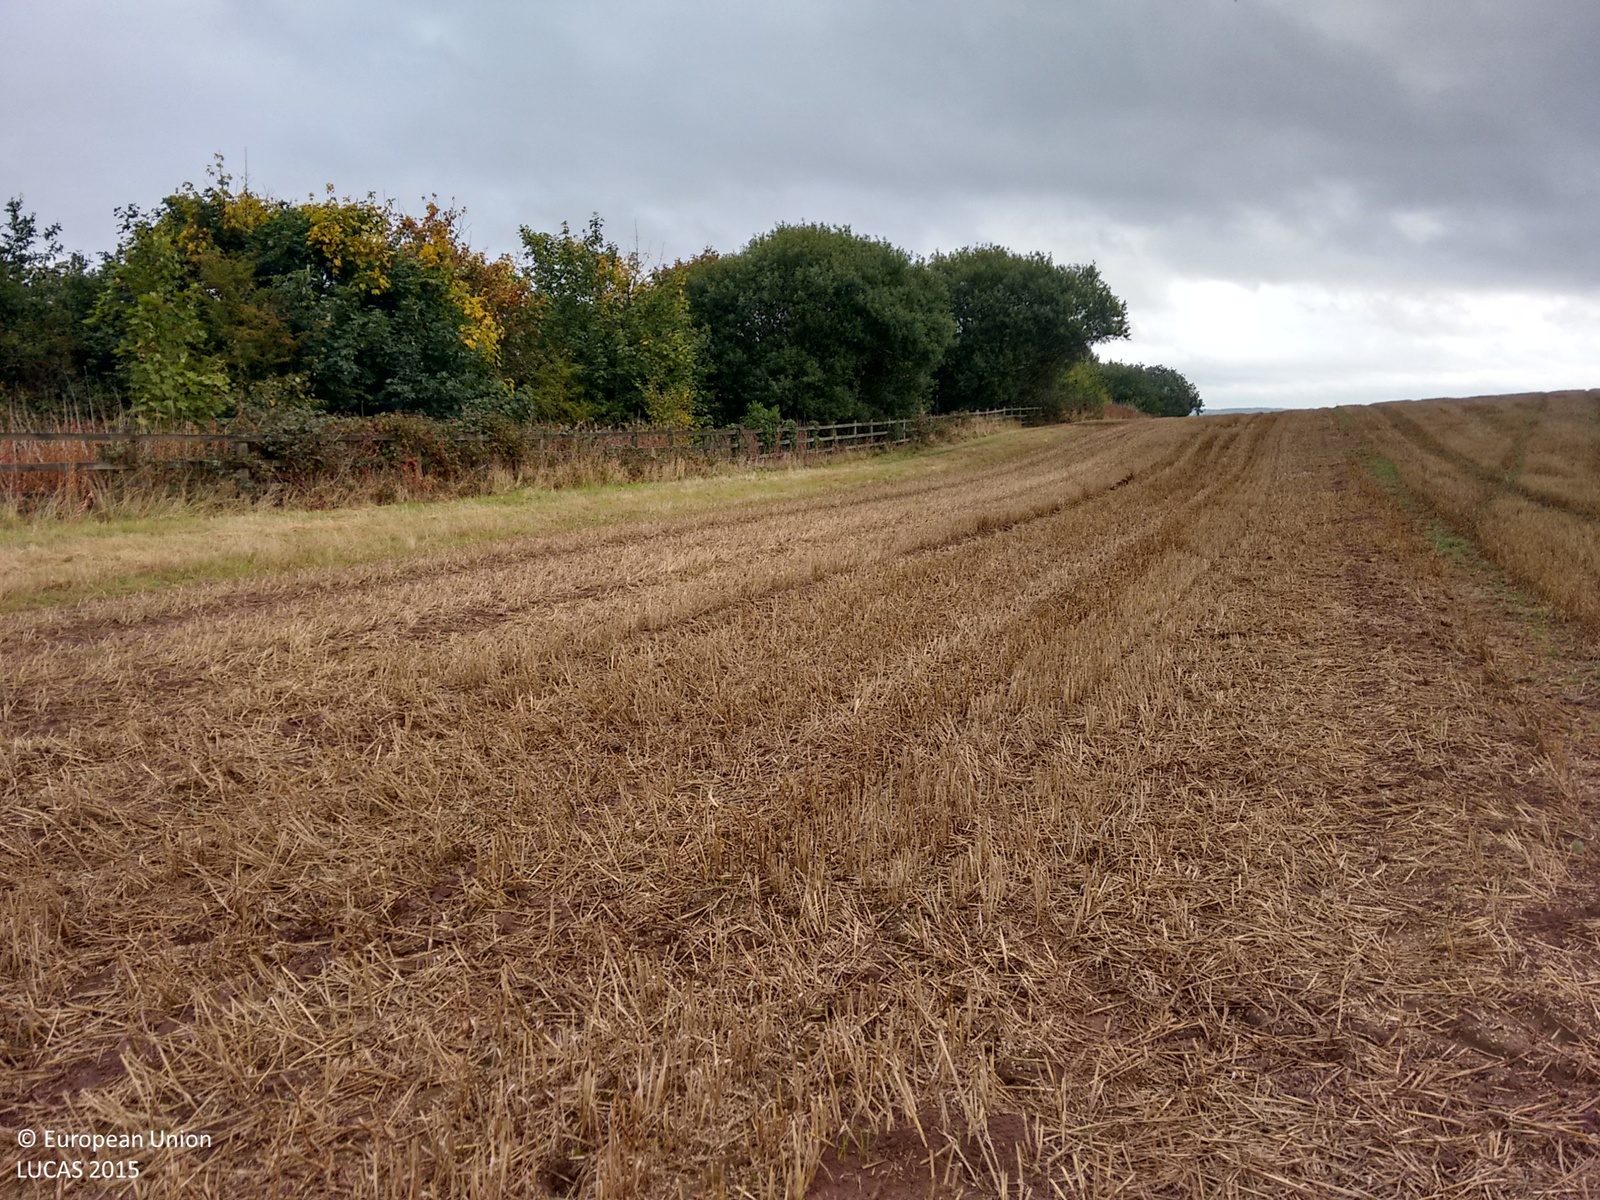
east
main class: Cropland
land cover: Common wheat
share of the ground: 10 - 25 %
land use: Agriculture (excluding fallow land and kitchen gardens)
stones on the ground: < 10 %
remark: Harvested field
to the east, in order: Common wheat; Grassland without tree/shrub cover; Fences; Spontaneously vegetated surfaces; Ditches and canals; Broadleaved woodland; Paved roads, cycling and walking lanes; Grassland without tree/shrub cover
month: October
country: GB
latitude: 52.6753
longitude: -2.3541
